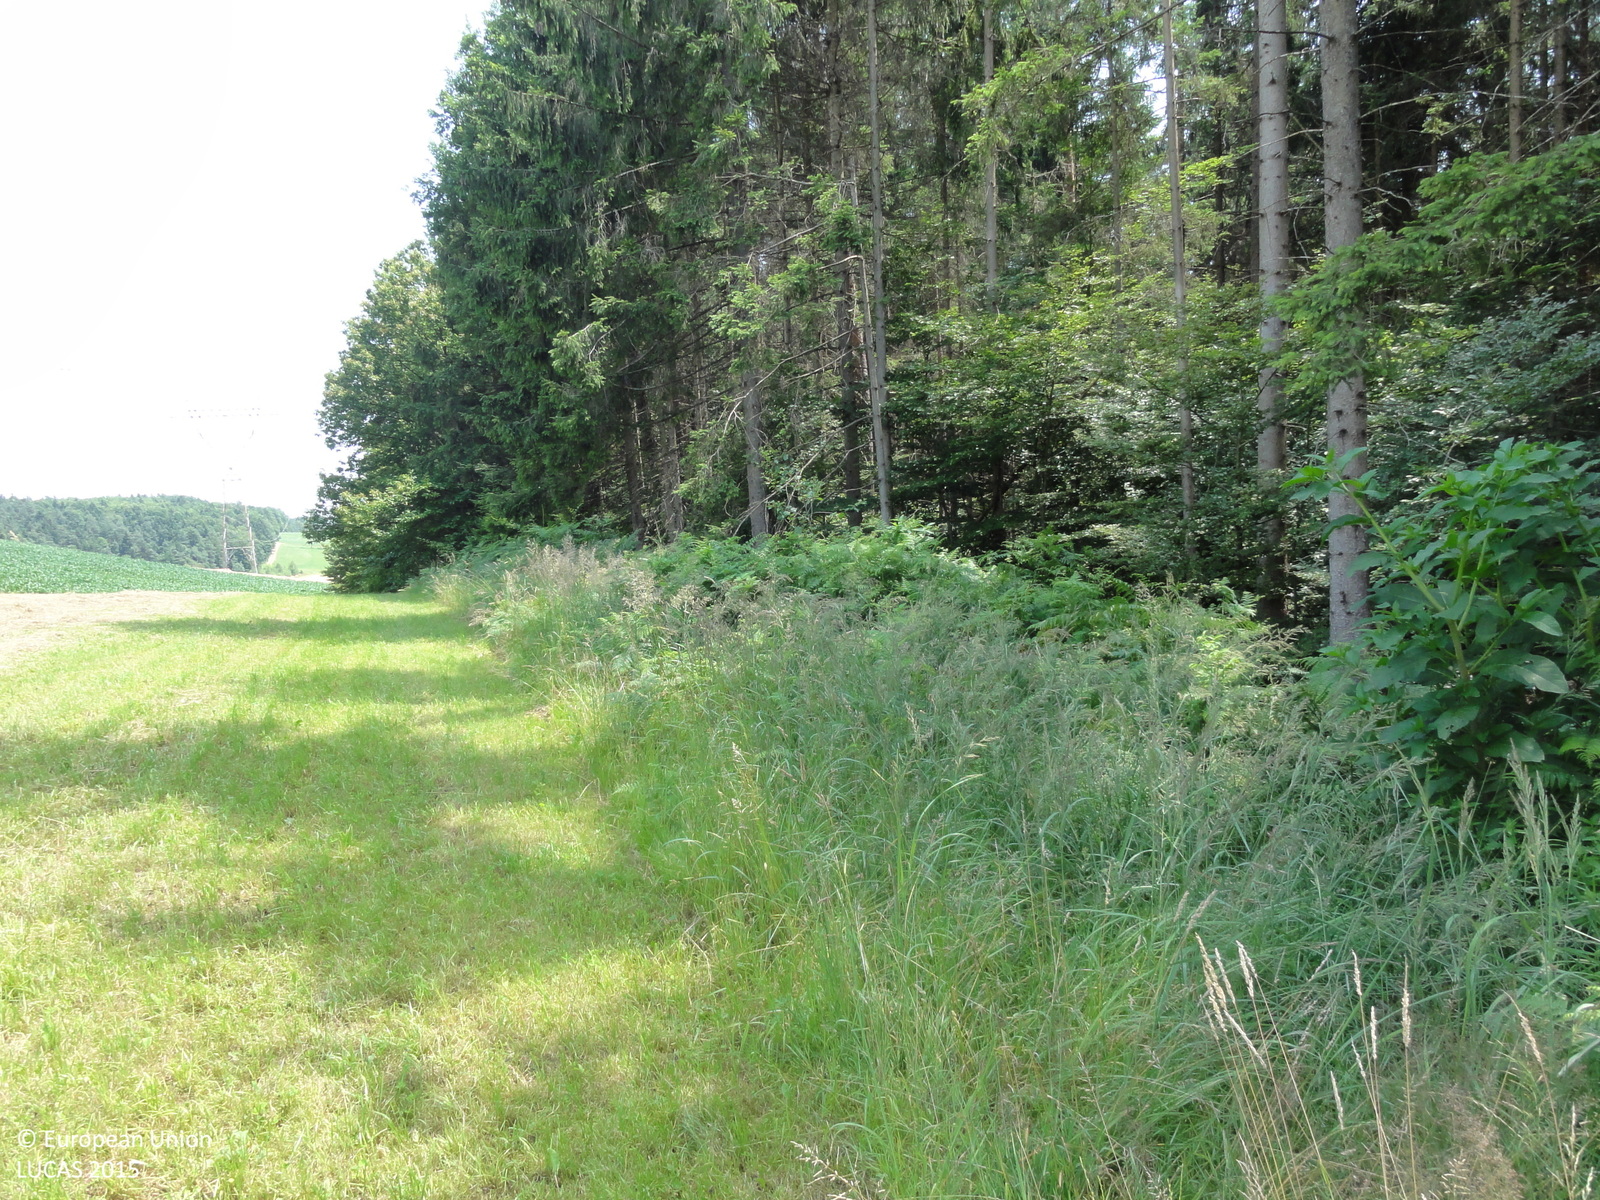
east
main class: Grassland
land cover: Grassland without tree/shrub cover
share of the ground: > 75 %
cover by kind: herbaceous plants 100 %
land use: Agriculture (excluding fallow land and kitchen gardens)
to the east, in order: Grassland without tree/shrub cover; Spruce dominated mixed woodland; Spruce dominated coniferous woodland; Spruce dominated mixed woodland; Shrubland without tree cover; Grassland without tree/shrub cover
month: July
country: SI
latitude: 46.3351
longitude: 15.5195
